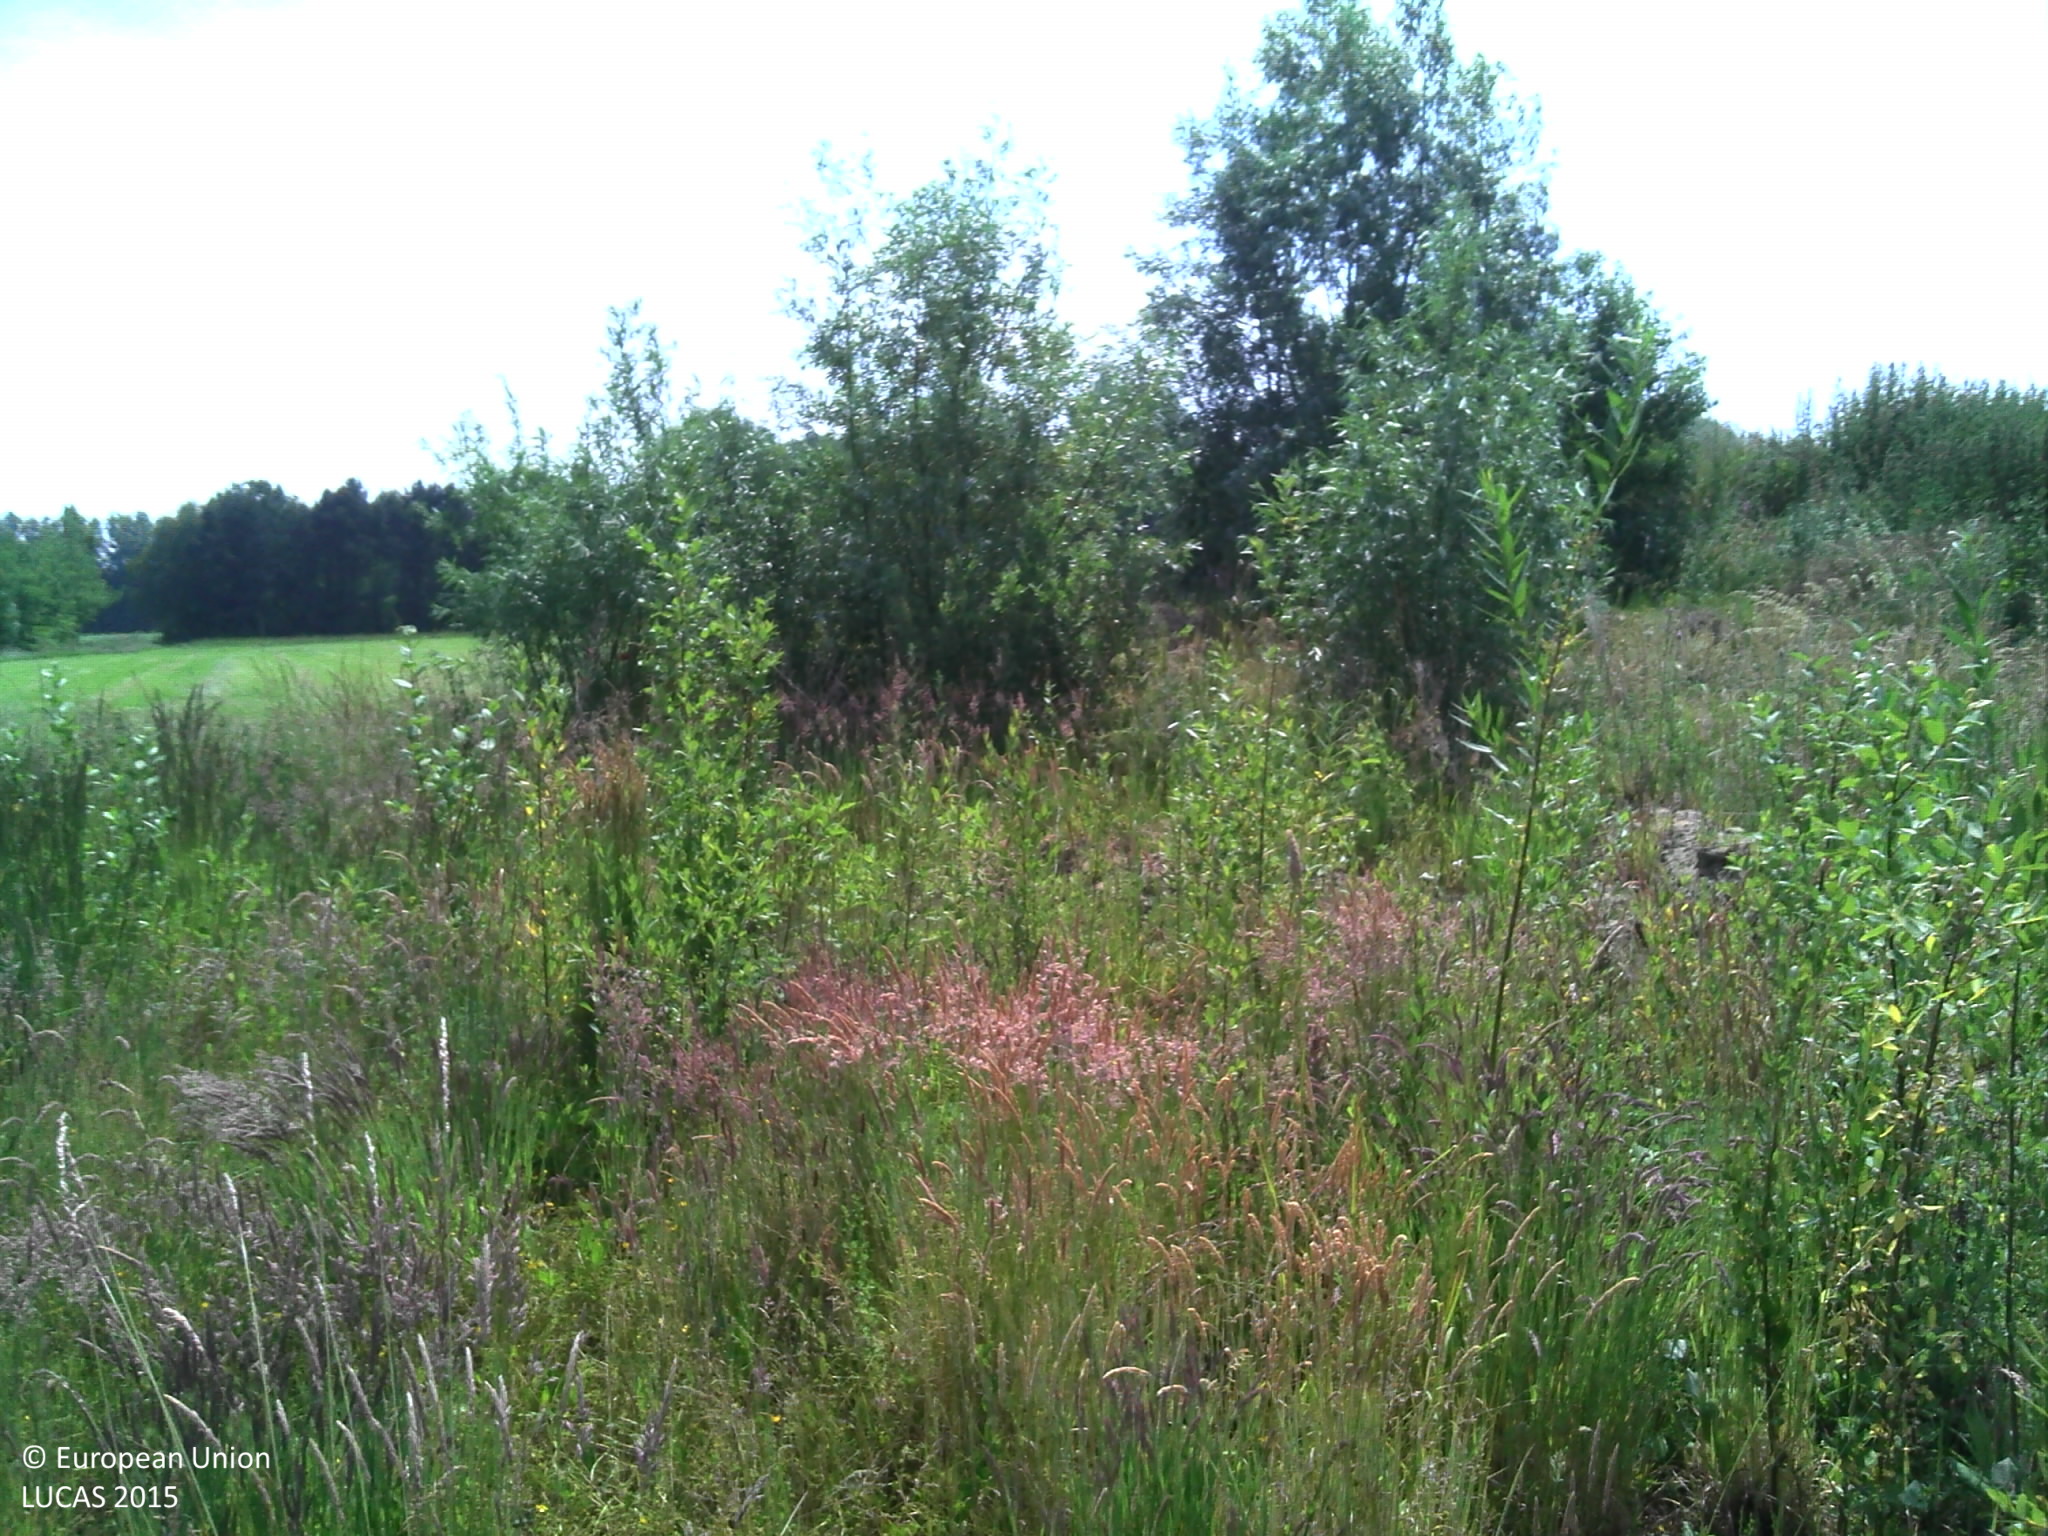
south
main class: Grassland
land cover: Grassland with sparse tree/shrub cover
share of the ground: > 75 %
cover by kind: herbaceous plants 95 %, broadleaved forest trees 5 %
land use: Agriculture (excluding fallow land and kitchen gardens)
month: June
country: BE
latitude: 51.2204
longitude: 4.0811
